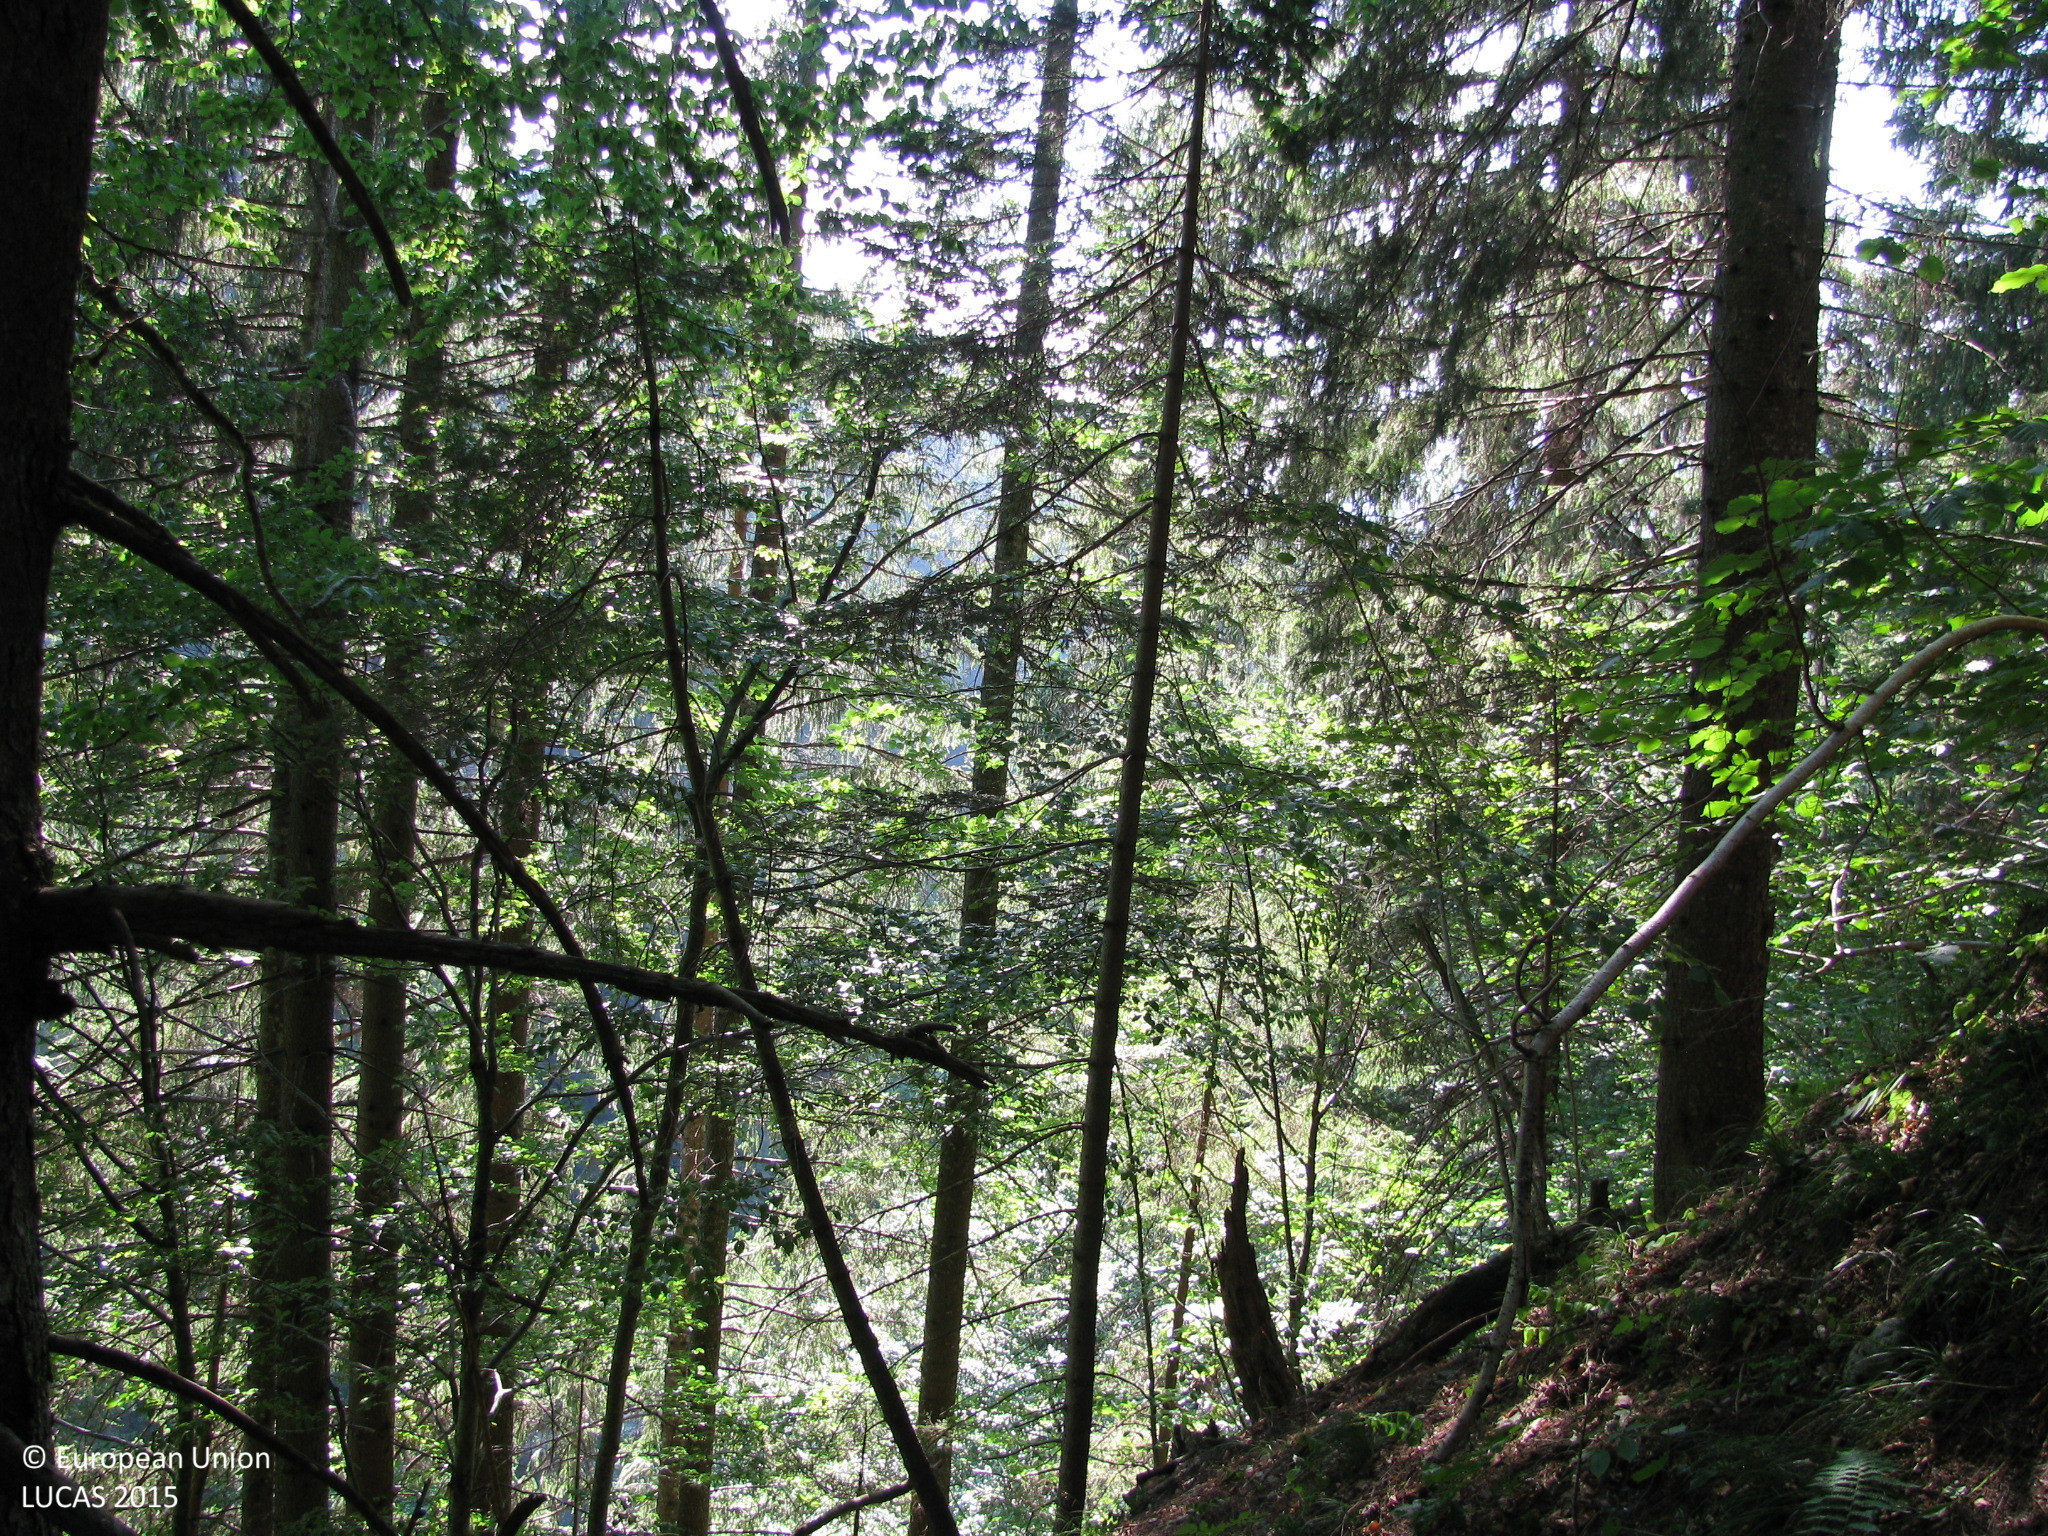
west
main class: Woodland
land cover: Spruce dominated mixed woodland
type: alpine coniferous forest
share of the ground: > 75 %
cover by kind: coniferous forest trees 50 %, broadleaved forest trees 35 %, unconsolidated bare surface 10 %, herbaceous plants 5 %
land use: Forestry
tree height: > 5 m
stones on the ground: < 10 %
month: July
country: AT
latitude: 46.6928
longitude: 12.8088
